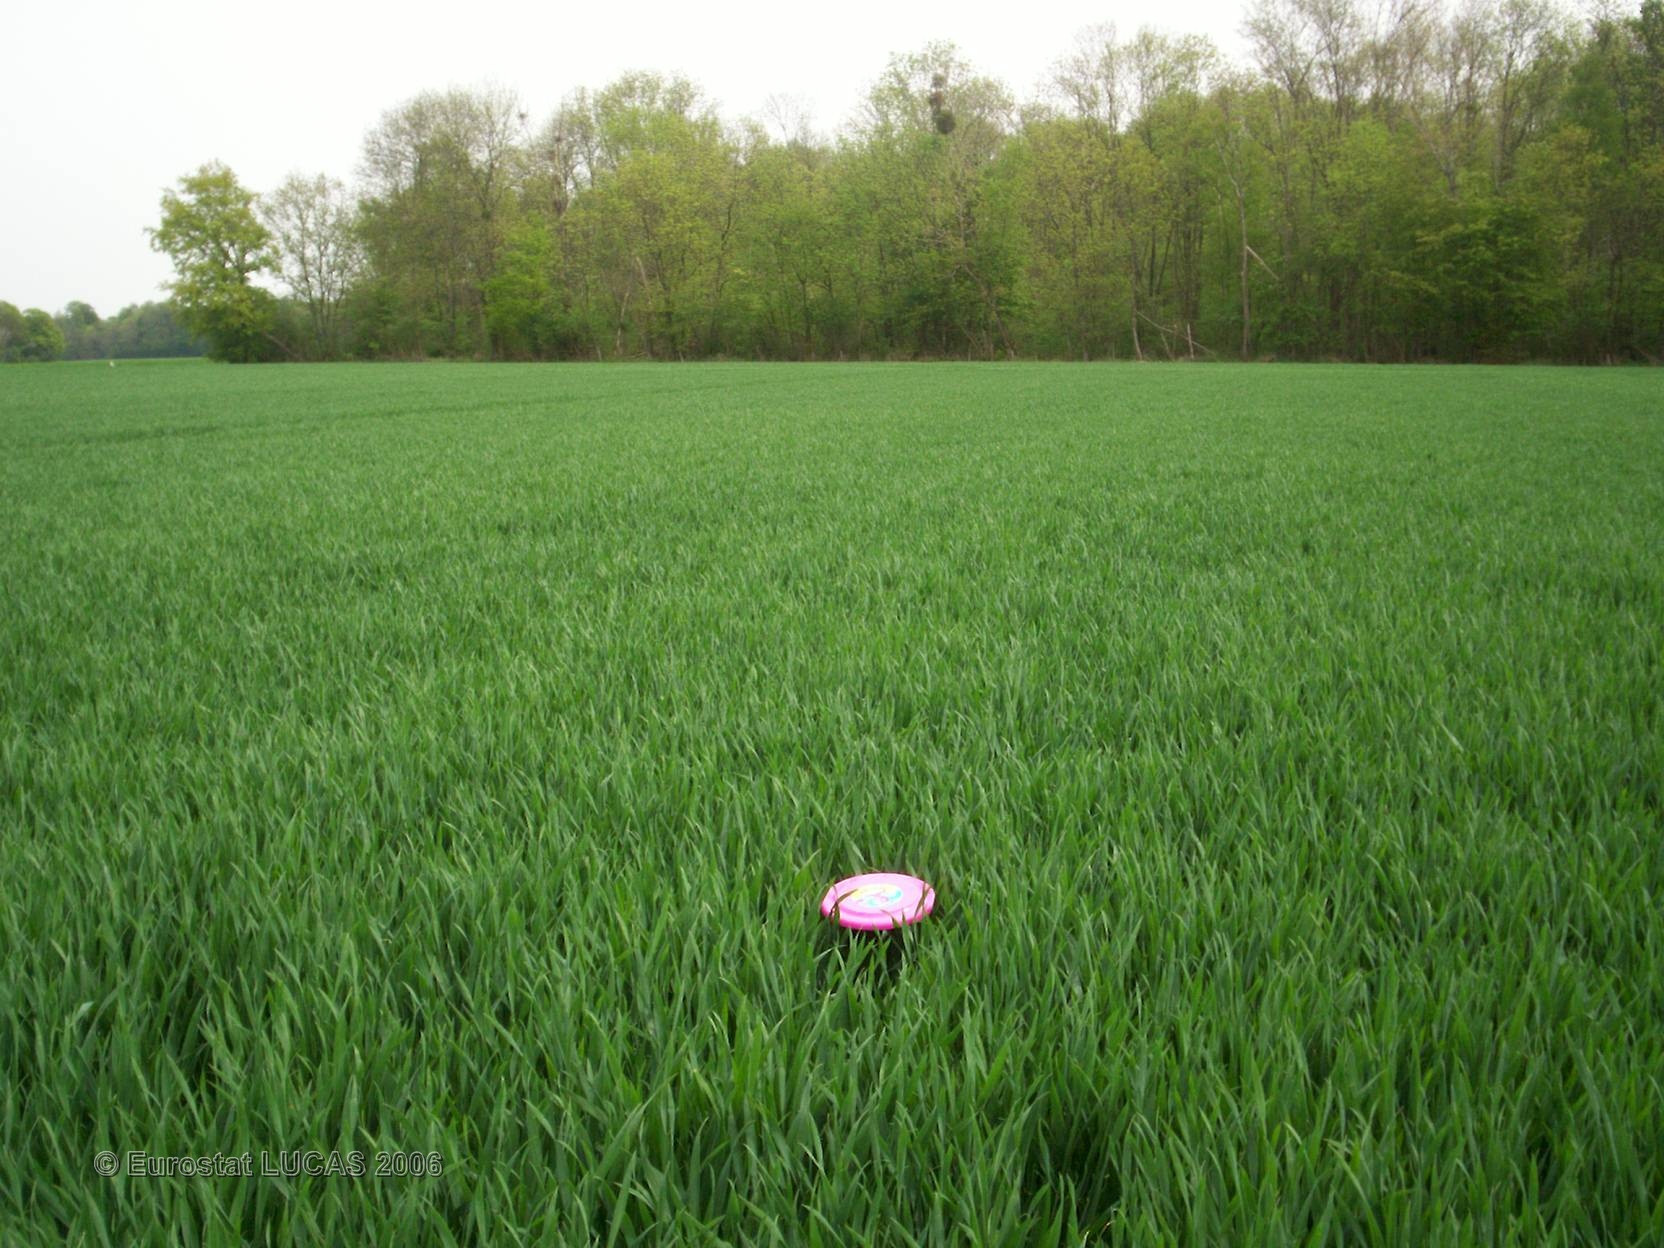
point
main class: Cropland
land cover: Common wheat
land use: Agriculture (excluding fallow land and kitchen gardens)
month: May
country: FR
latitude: 48.6801
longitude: 2.8877
